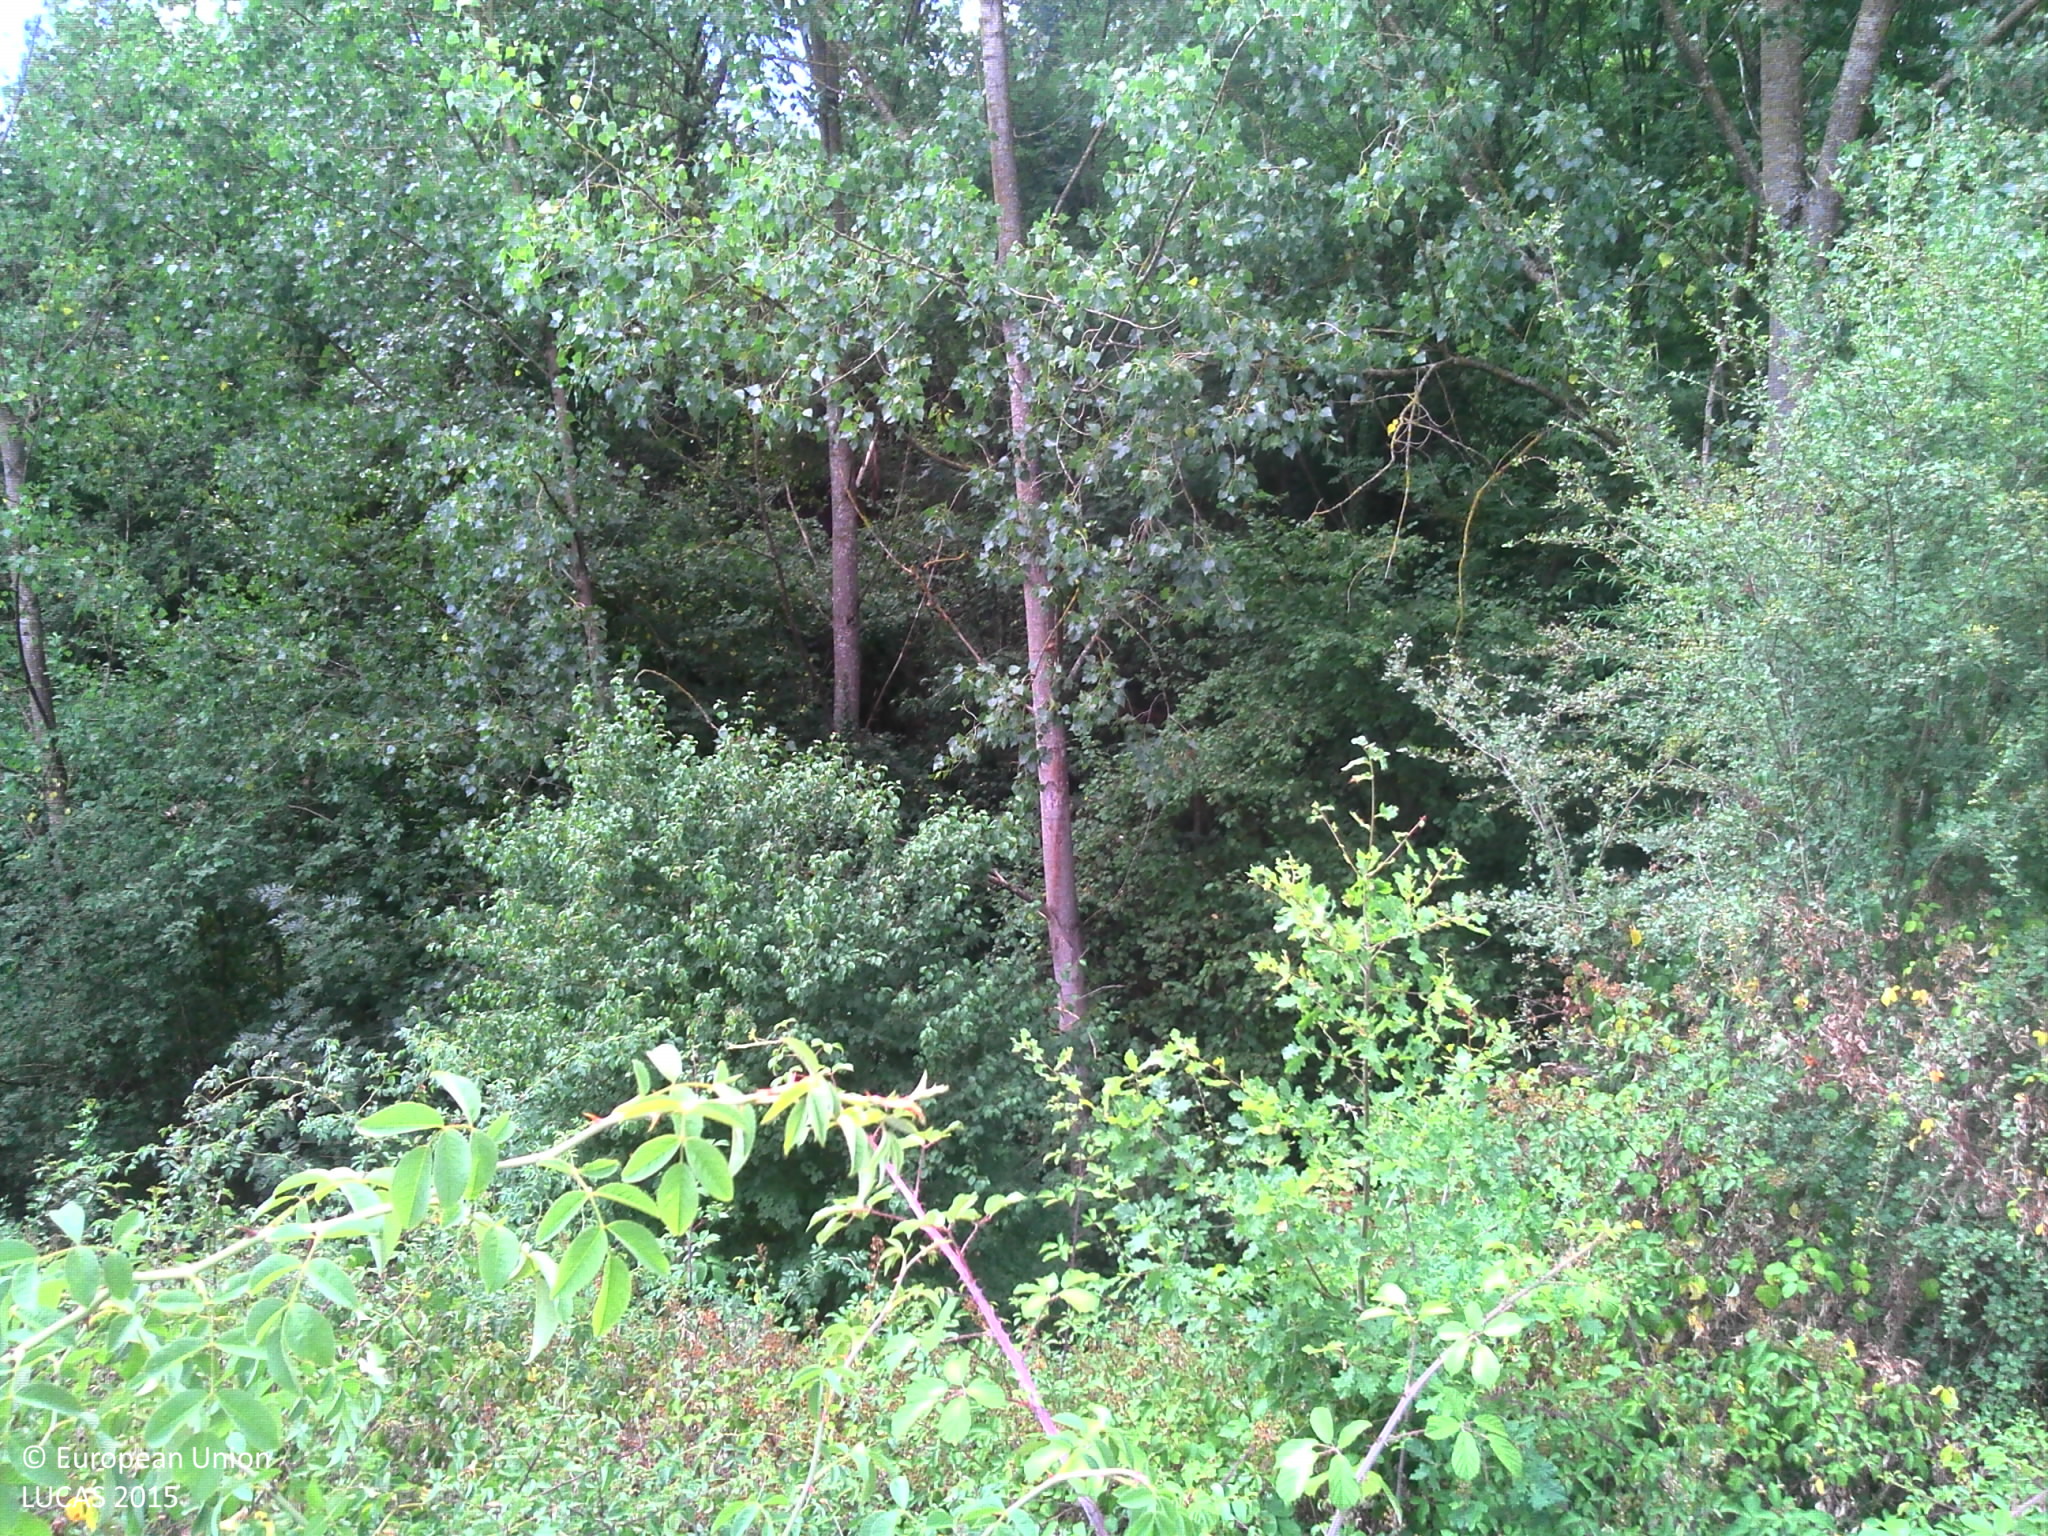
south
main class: Grassland
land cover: Spontaneously vegetated surfaces
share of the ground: > 75 %
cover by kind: herbaceous plants 80 %, lichens and mosses 15 %, shrubs 5 %
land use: Semi-natural and natural areas not in use
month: July
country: FR
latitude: 45.7796
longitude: 4.5628
